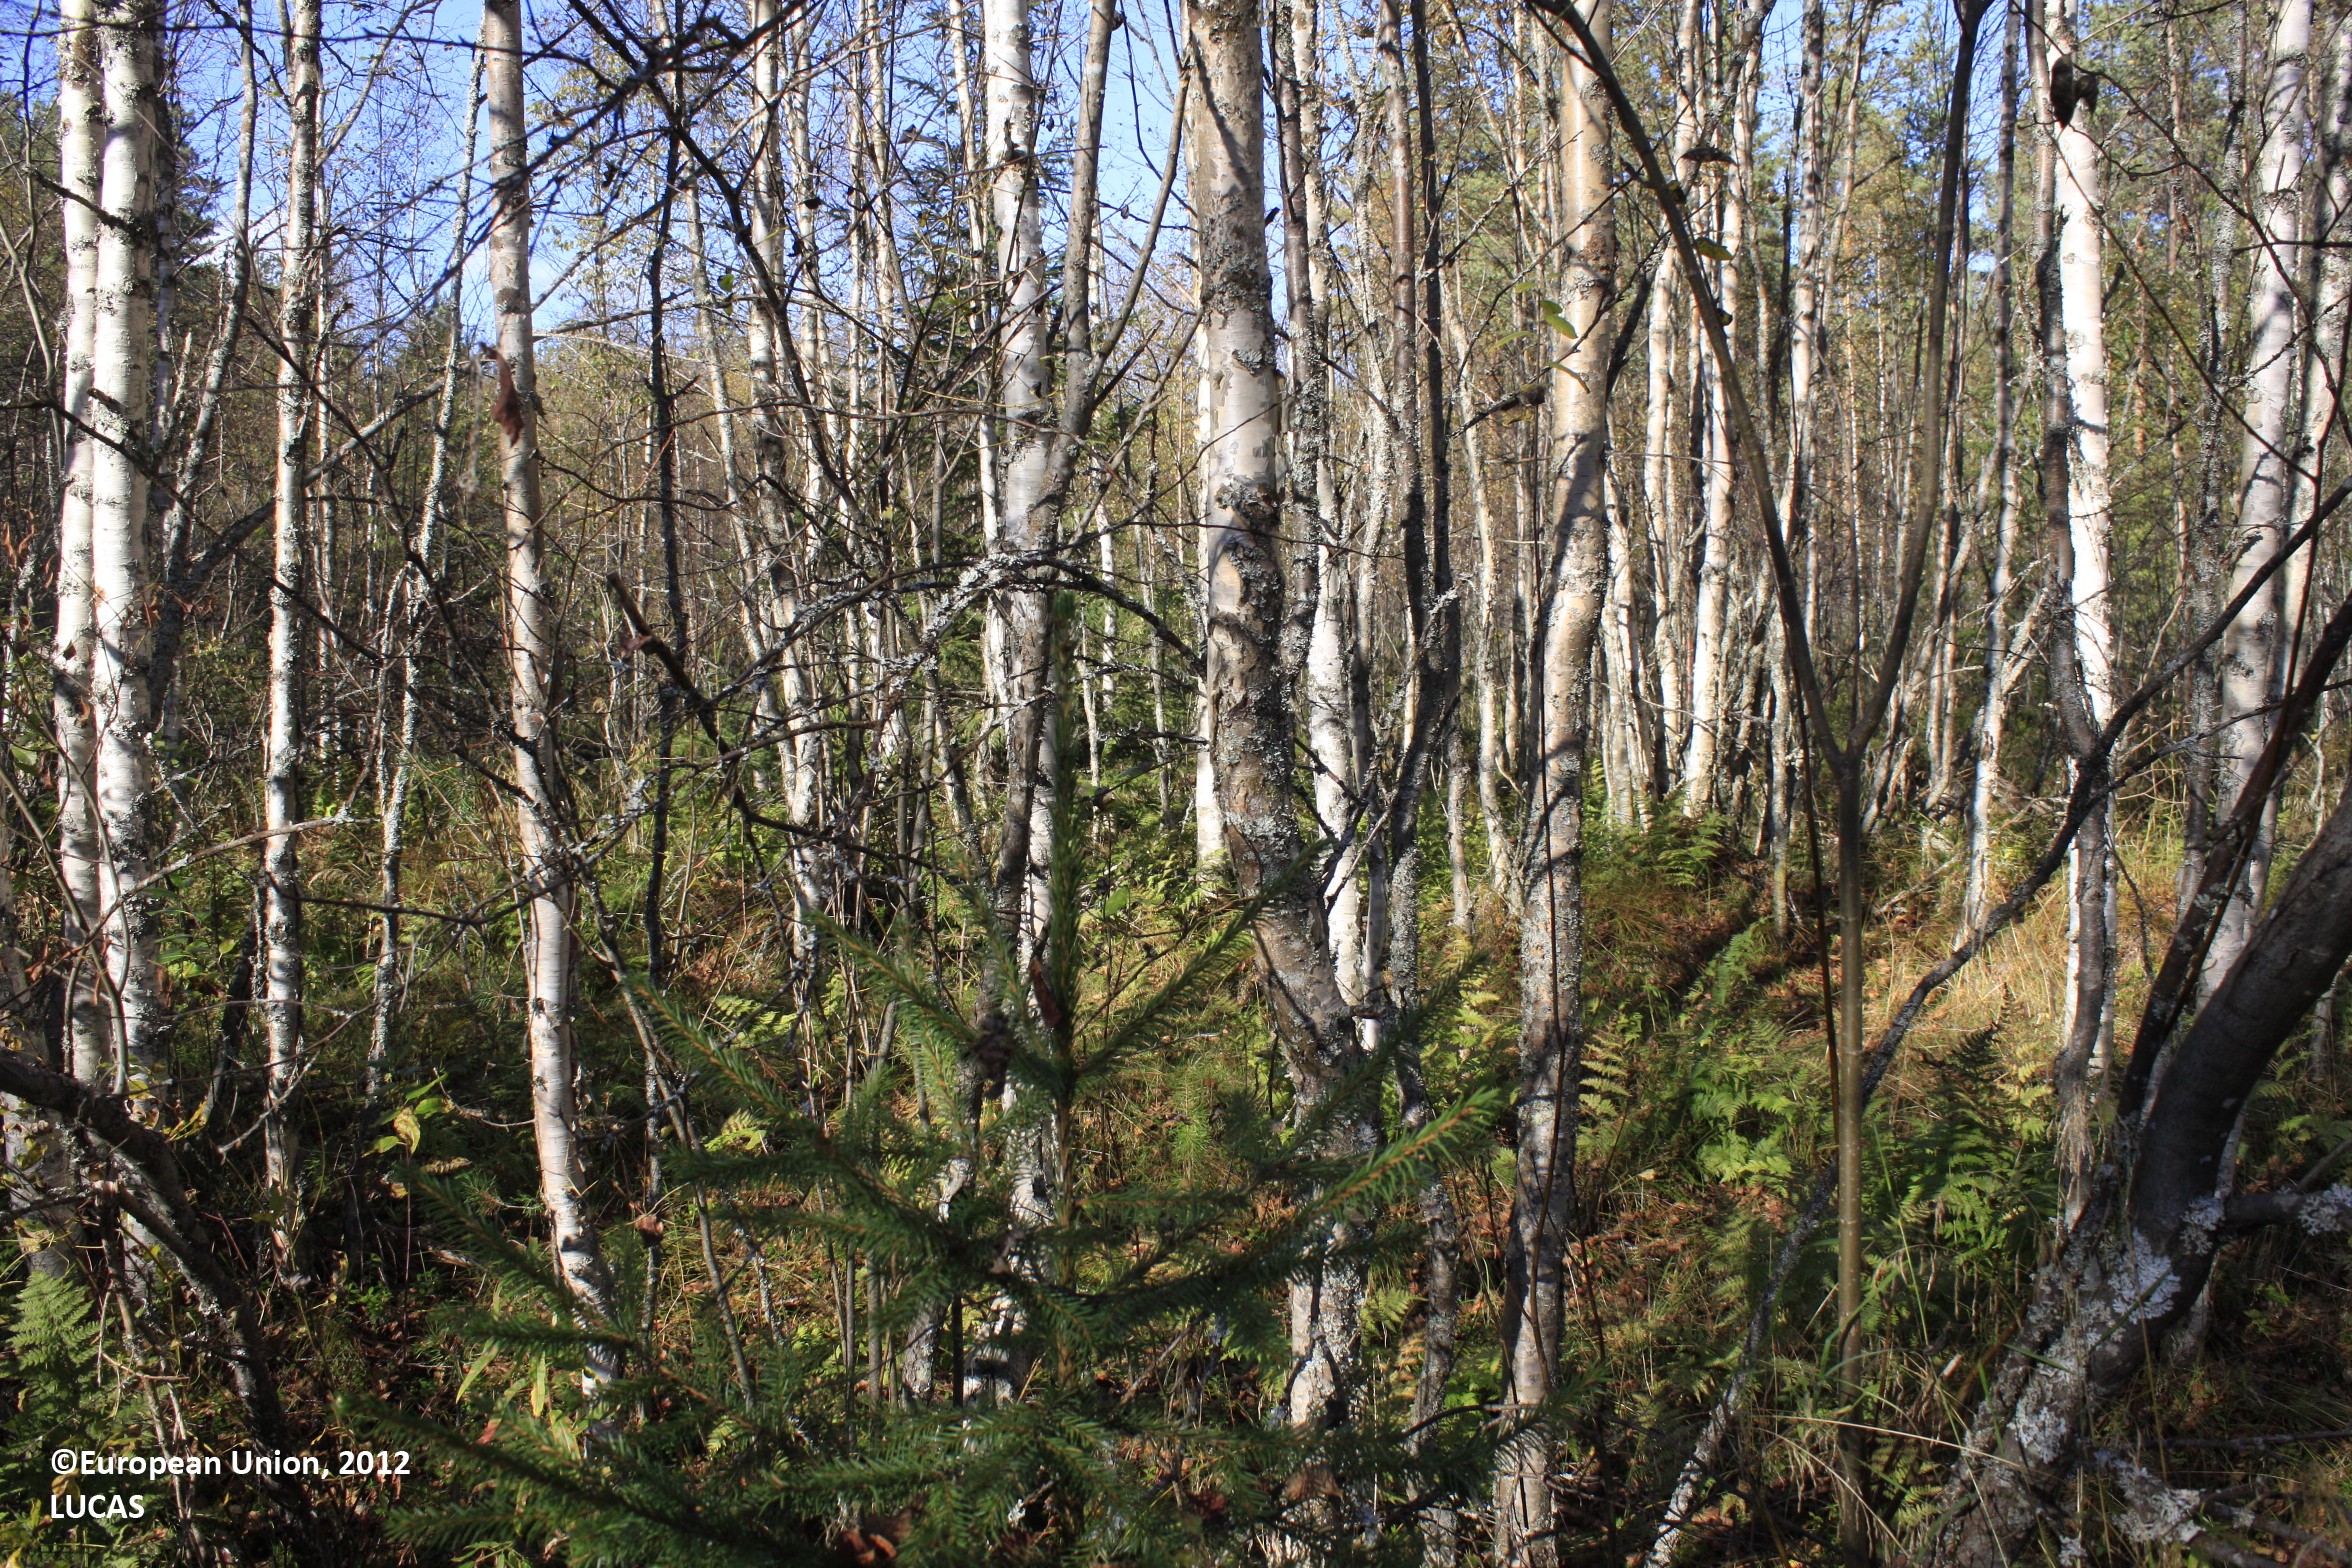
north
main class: Woodland
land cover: Broadleaved woodland
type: boreal forest
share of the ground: 25 - 50 %
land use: Forestry
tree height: > 5 m
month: September
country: FI
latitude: 63.7730
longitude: 25.9074
